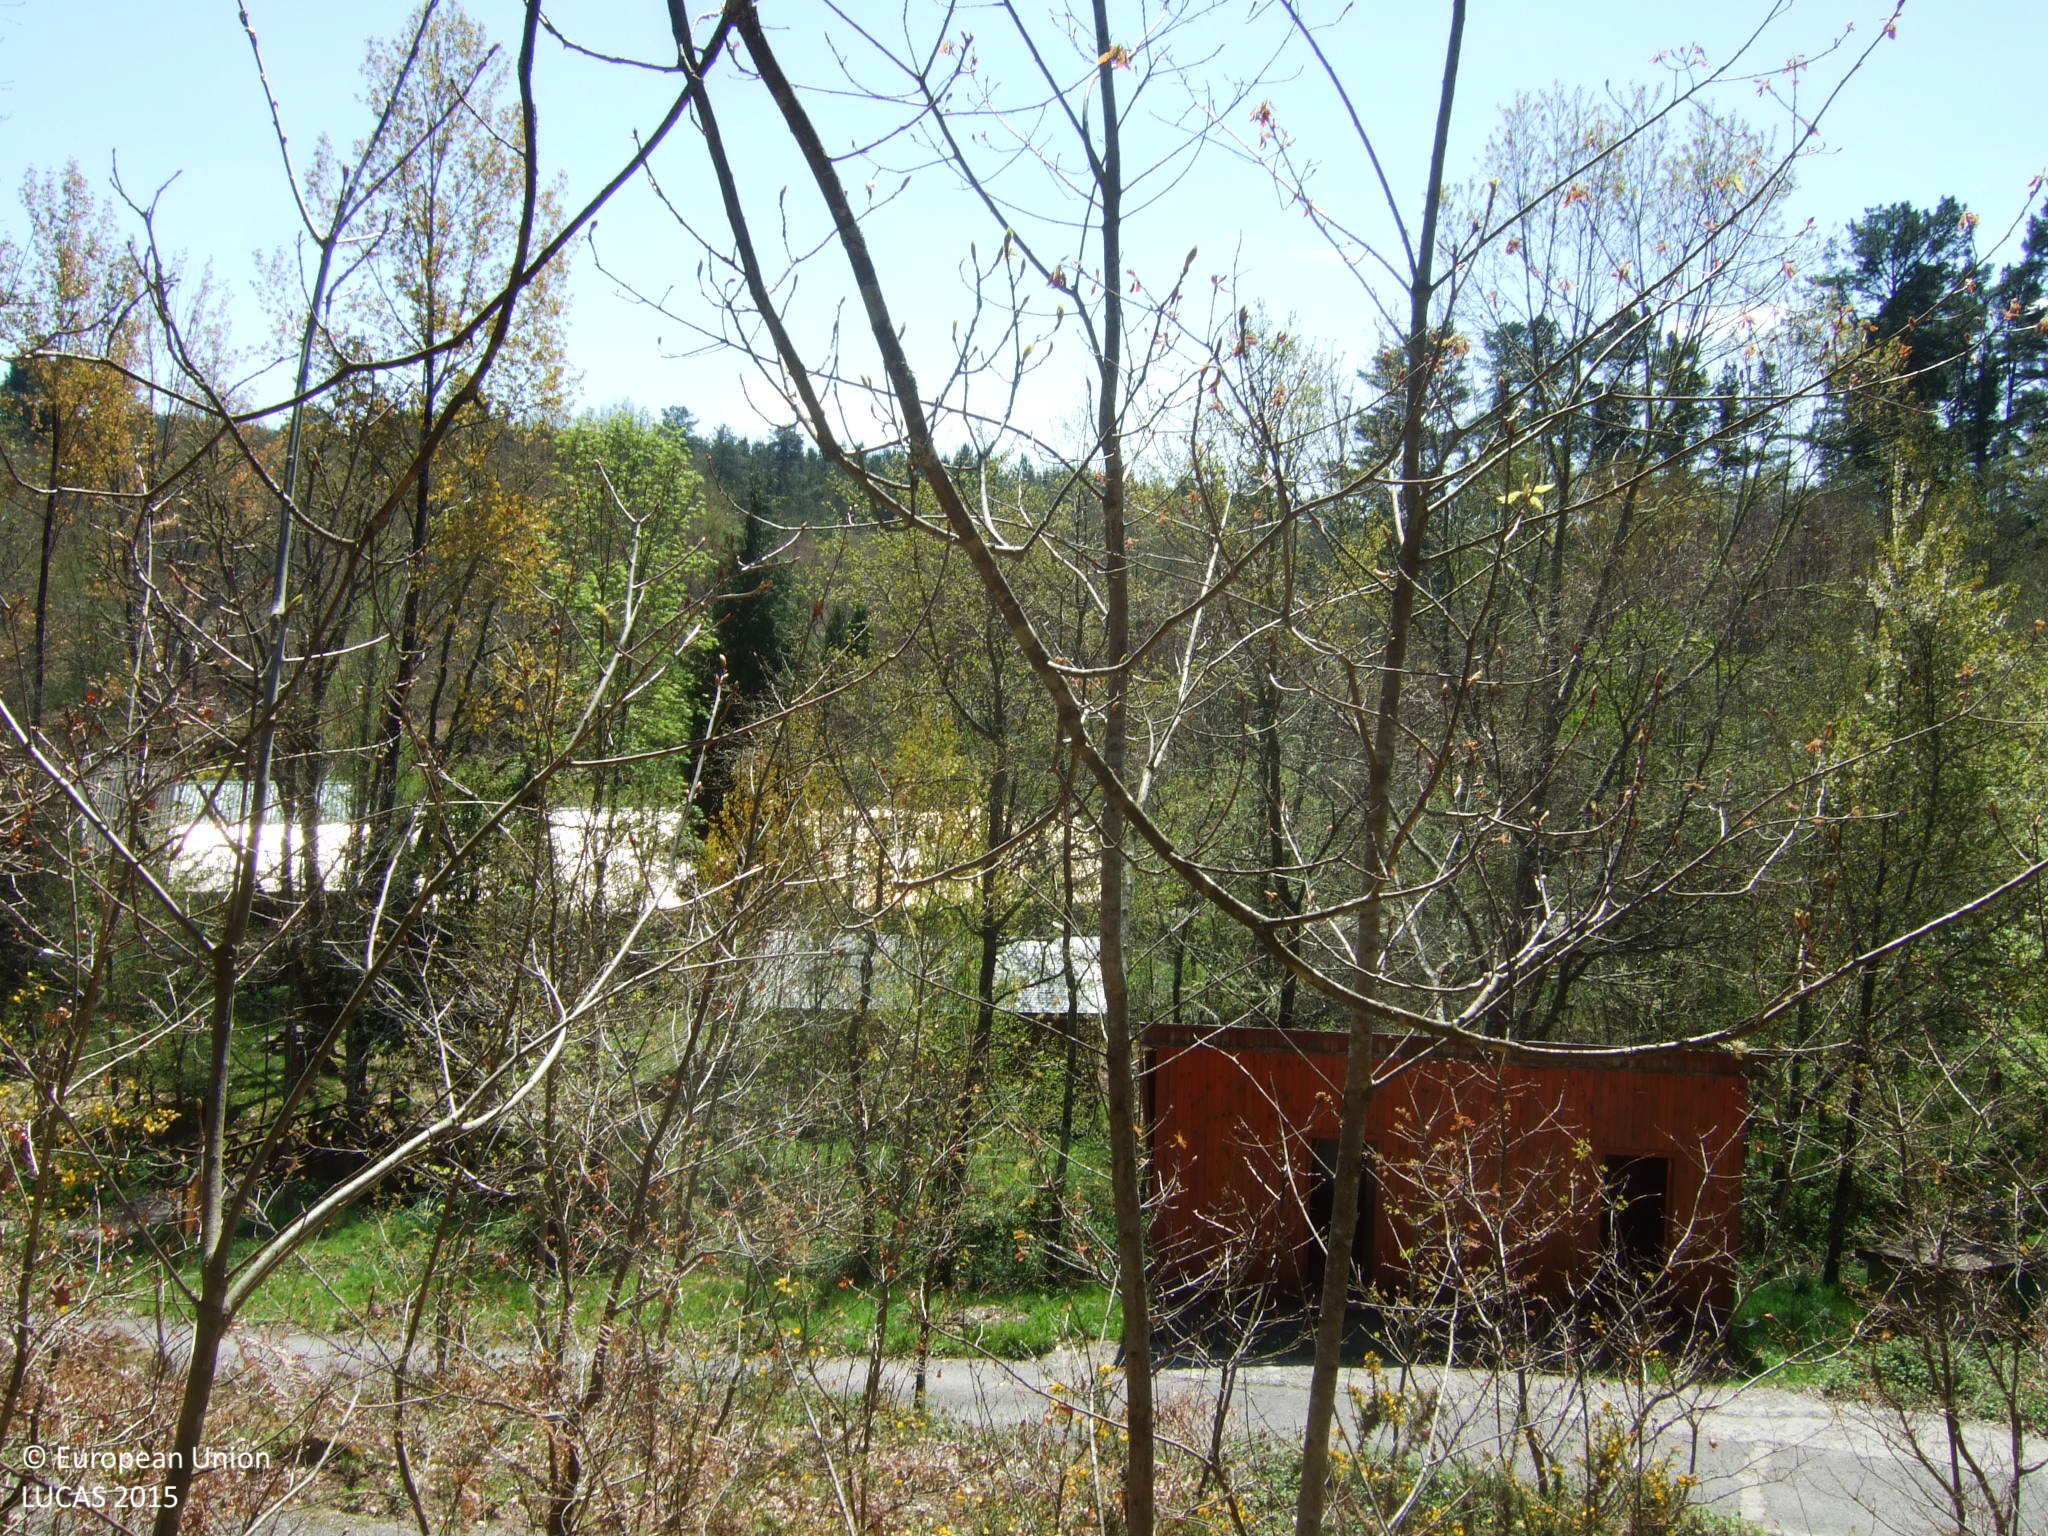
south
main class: Woodland
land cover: Broadleaved woodland
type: acidophilous oak and oak-birch forest
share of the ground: > 75 %
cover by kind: broadleaved forest trees 60 %, shrubs 30 %, unconsolidated bare surface 10 %
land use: Forestry
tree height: > 5 m
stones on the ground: < 10 %
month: April
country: ES
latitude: 42.9922
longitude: -7.6305
